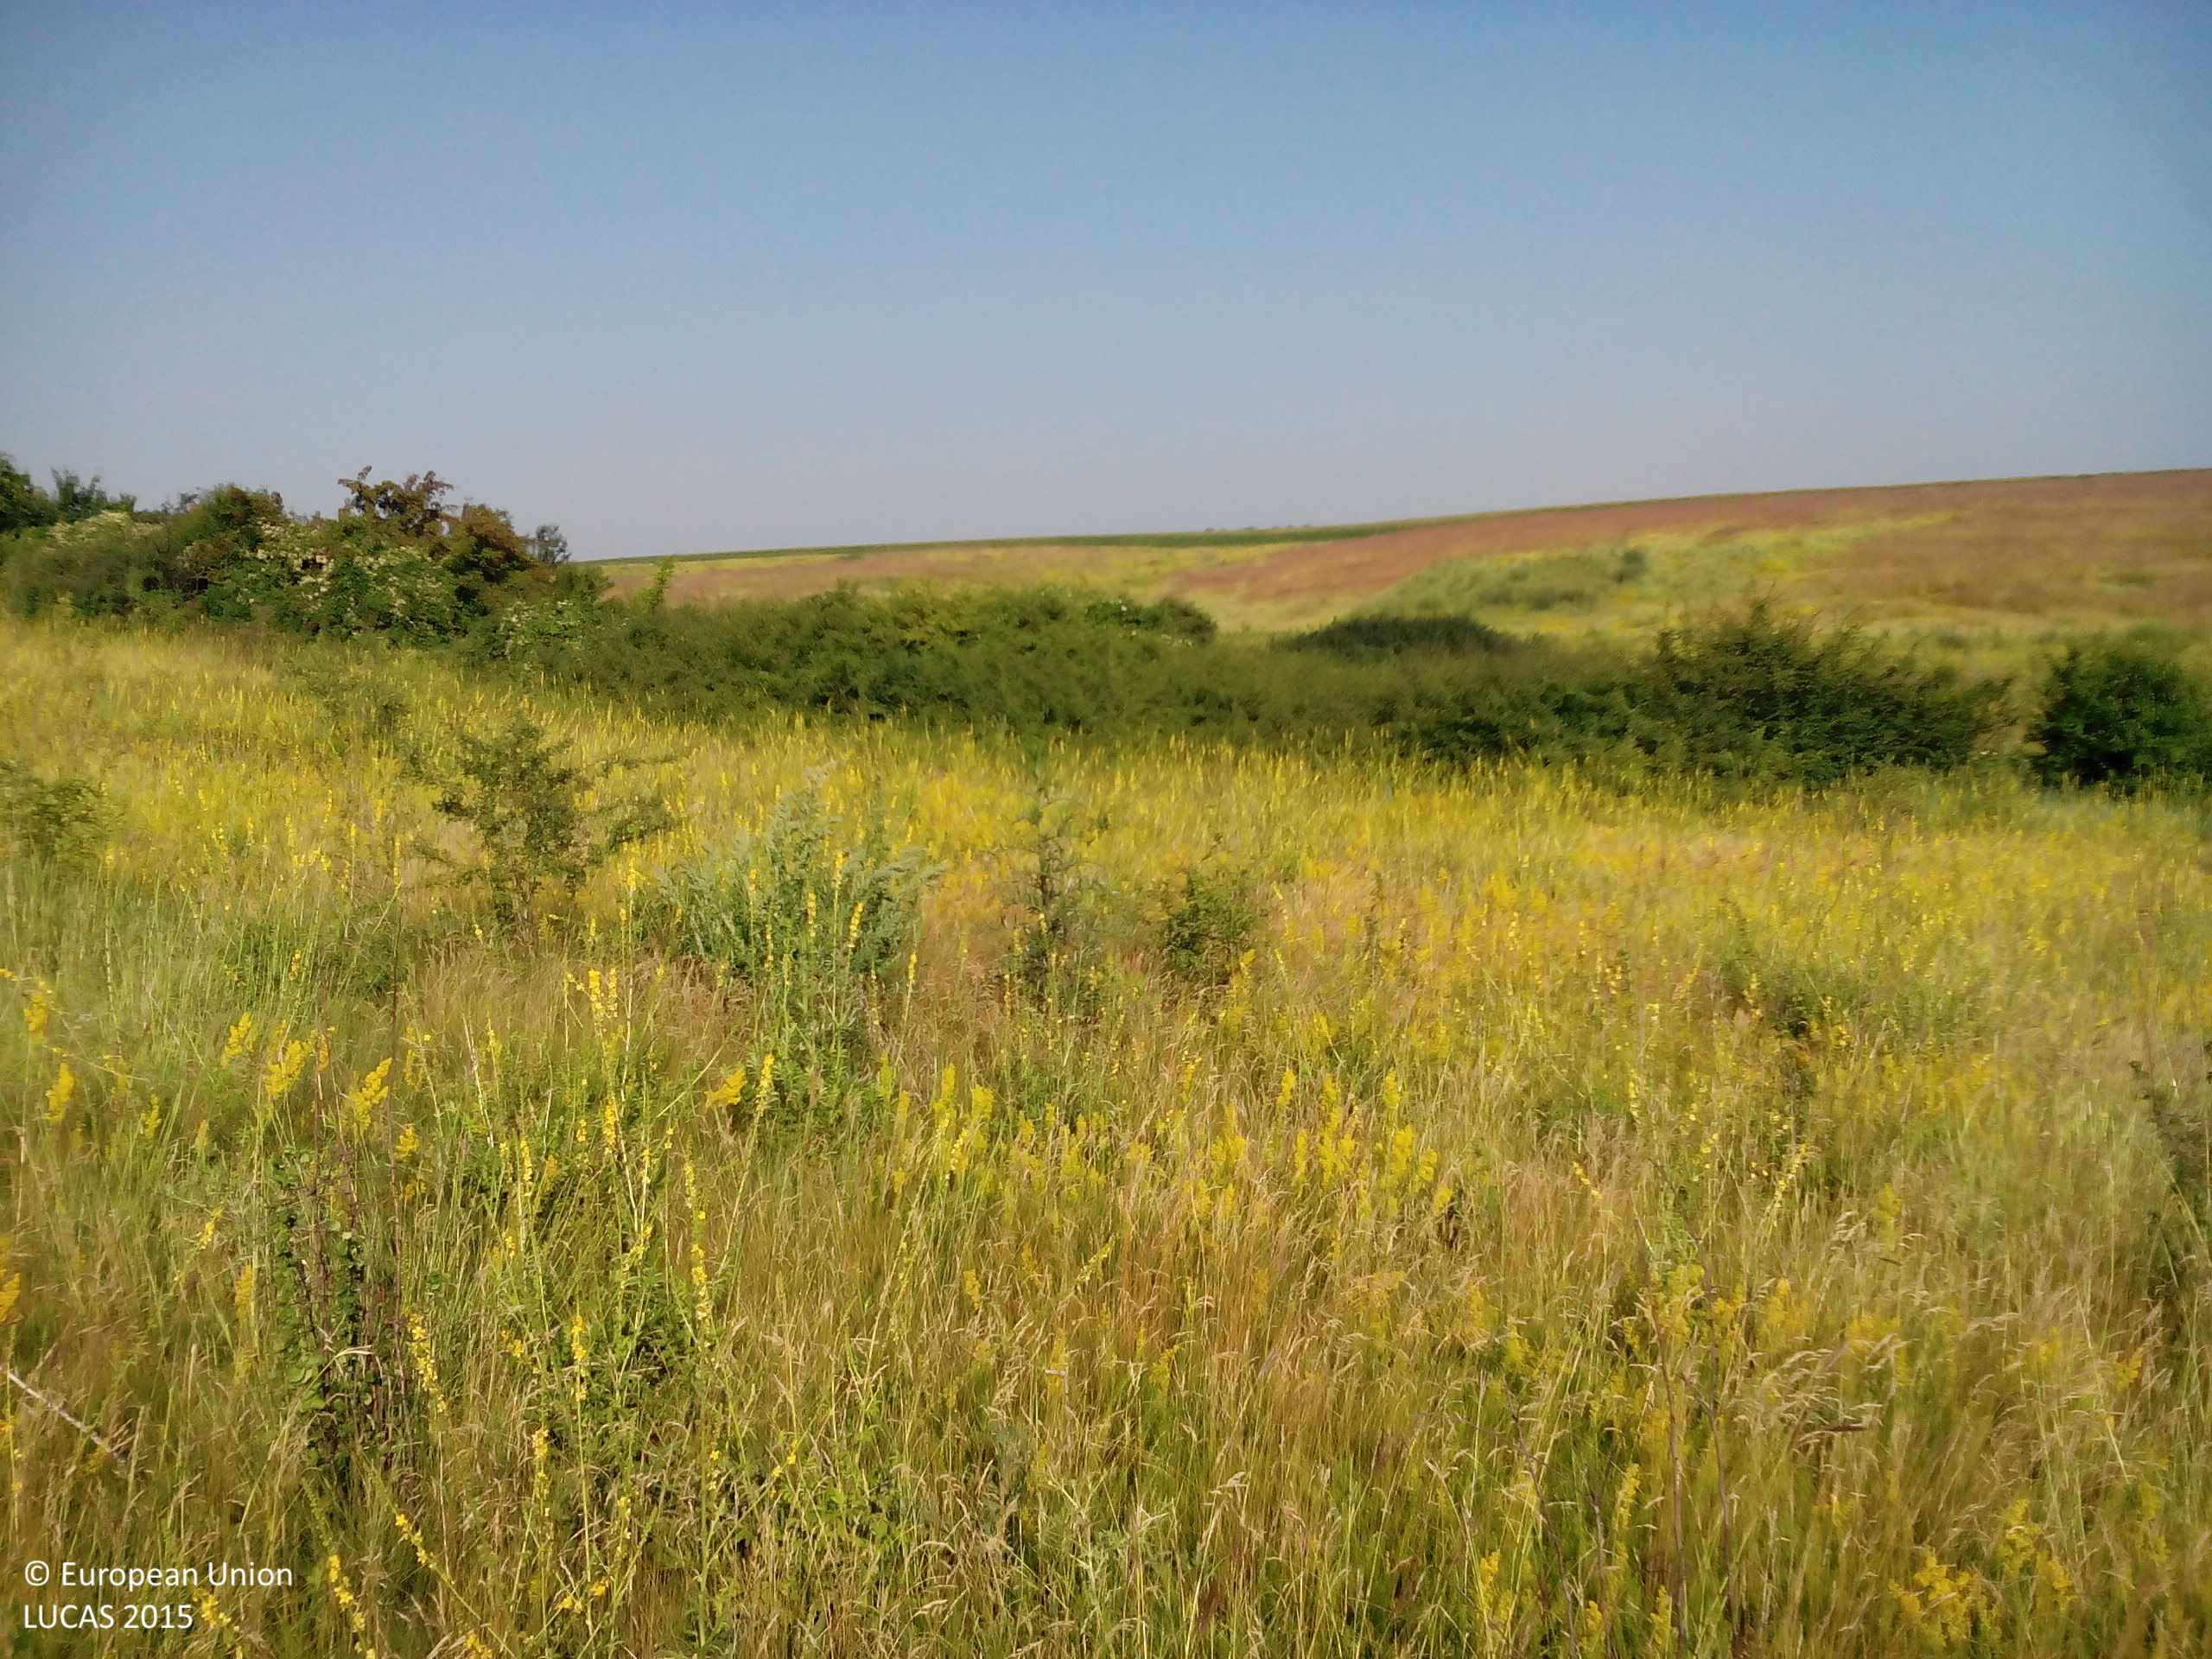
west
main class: Grassland
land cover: Spontaneously vegetated surfaces
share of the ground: > 75 %
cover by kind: herbaceous plants 95 %, shrubs 5 %
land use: Abandoned areas
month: July
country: BG
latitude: 43.3458
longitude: 24.2294
